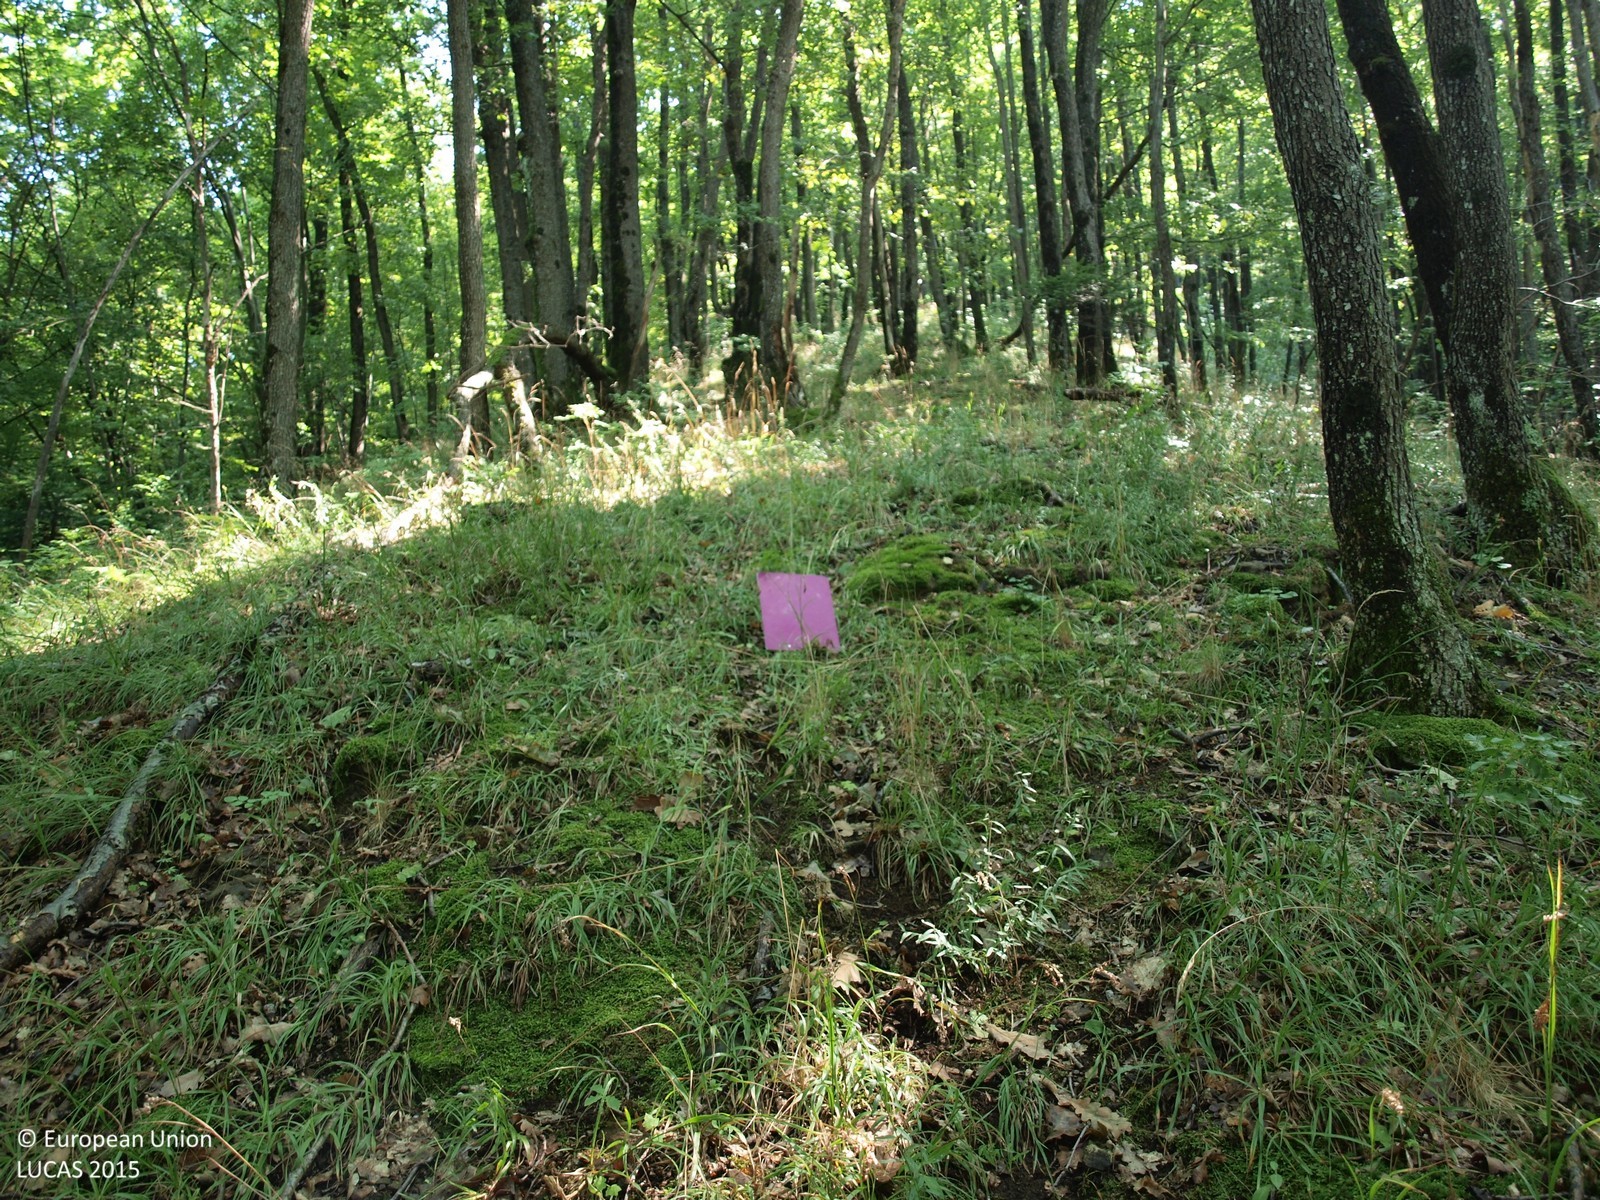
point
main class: Woodland
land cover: Broadleaved woodland
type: mesophytic deciduous forest
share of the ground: > 75 %
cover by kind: broadleaved forest trees 100 %
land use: Forestry
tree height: > 5 m
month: July
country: HR
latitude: 45.9166
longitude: 15.9160
